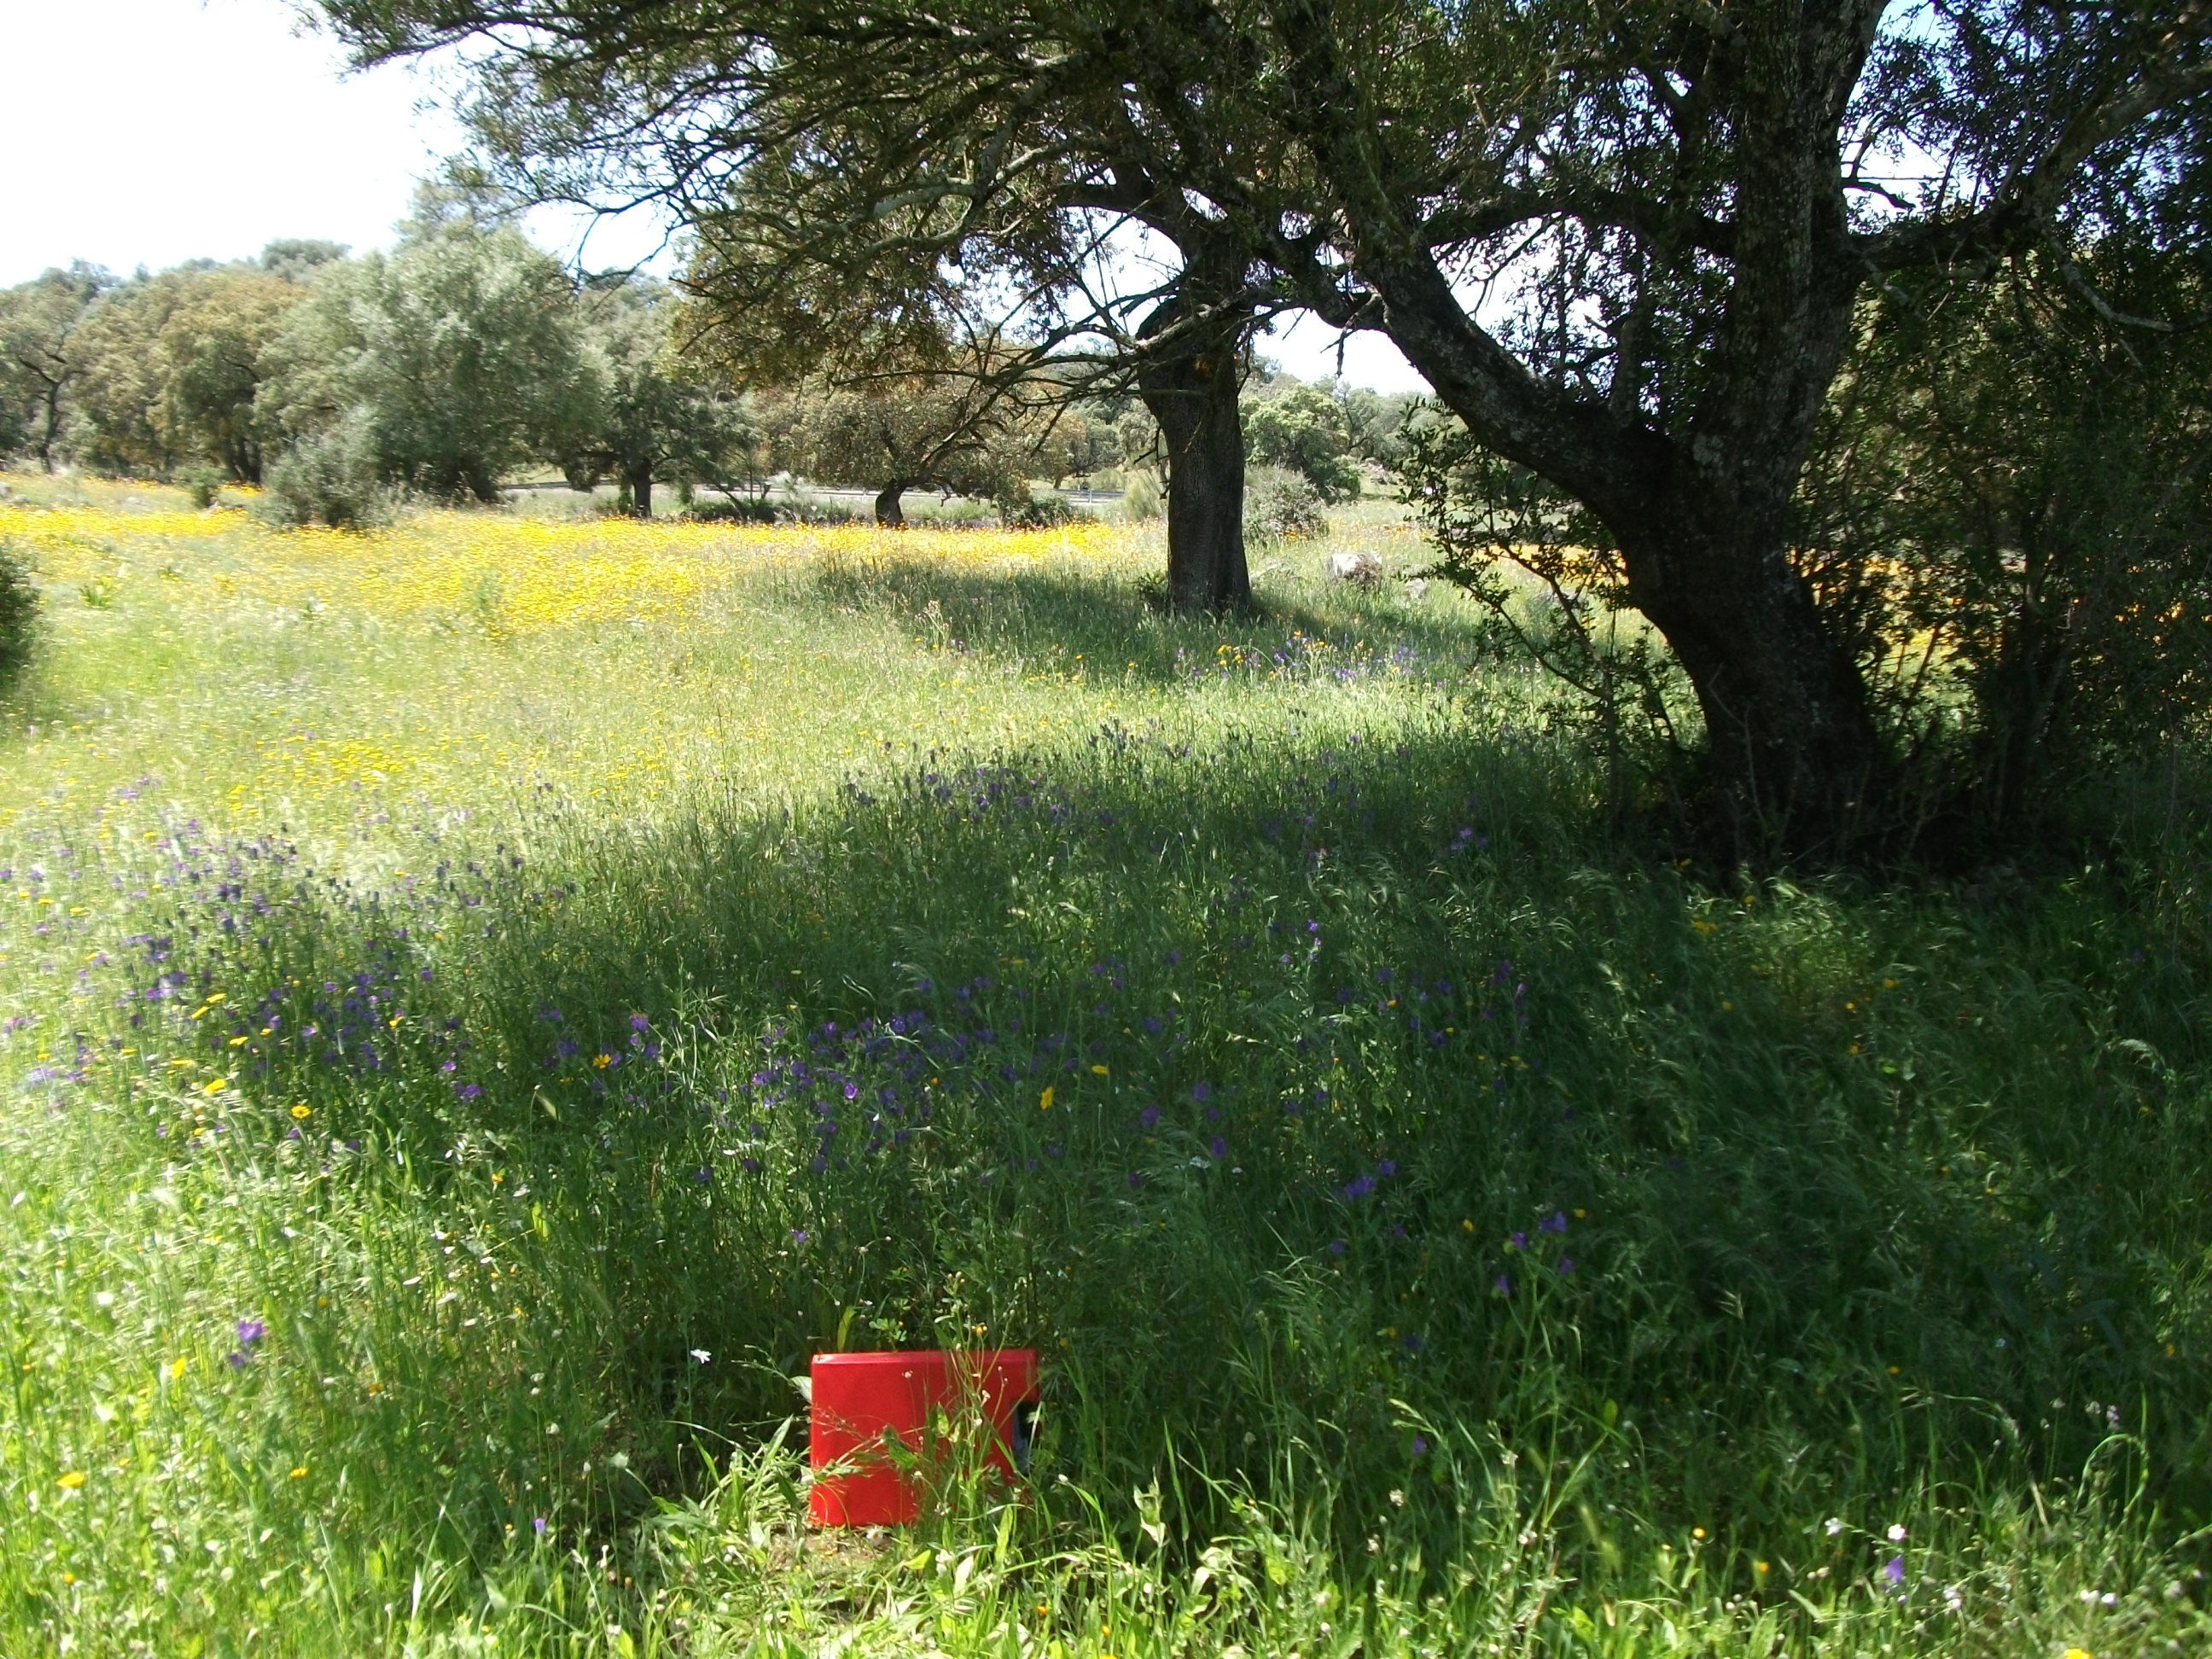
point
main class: Woodland
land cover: Broadleaved woodland
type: broadleaved evergreen forest
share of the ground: 50 - 75 %
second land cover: Spontaneously vegetated surfaces
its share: > 75 %
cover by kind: broadleaved forest trees 70 %, herbaceous plants 30 %
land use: Forestry
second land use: Agriculture (excluding fallow land and kitchen gardens)
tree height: > 5 m
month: April
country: ES
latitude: 37.9690
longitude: -7.0495
